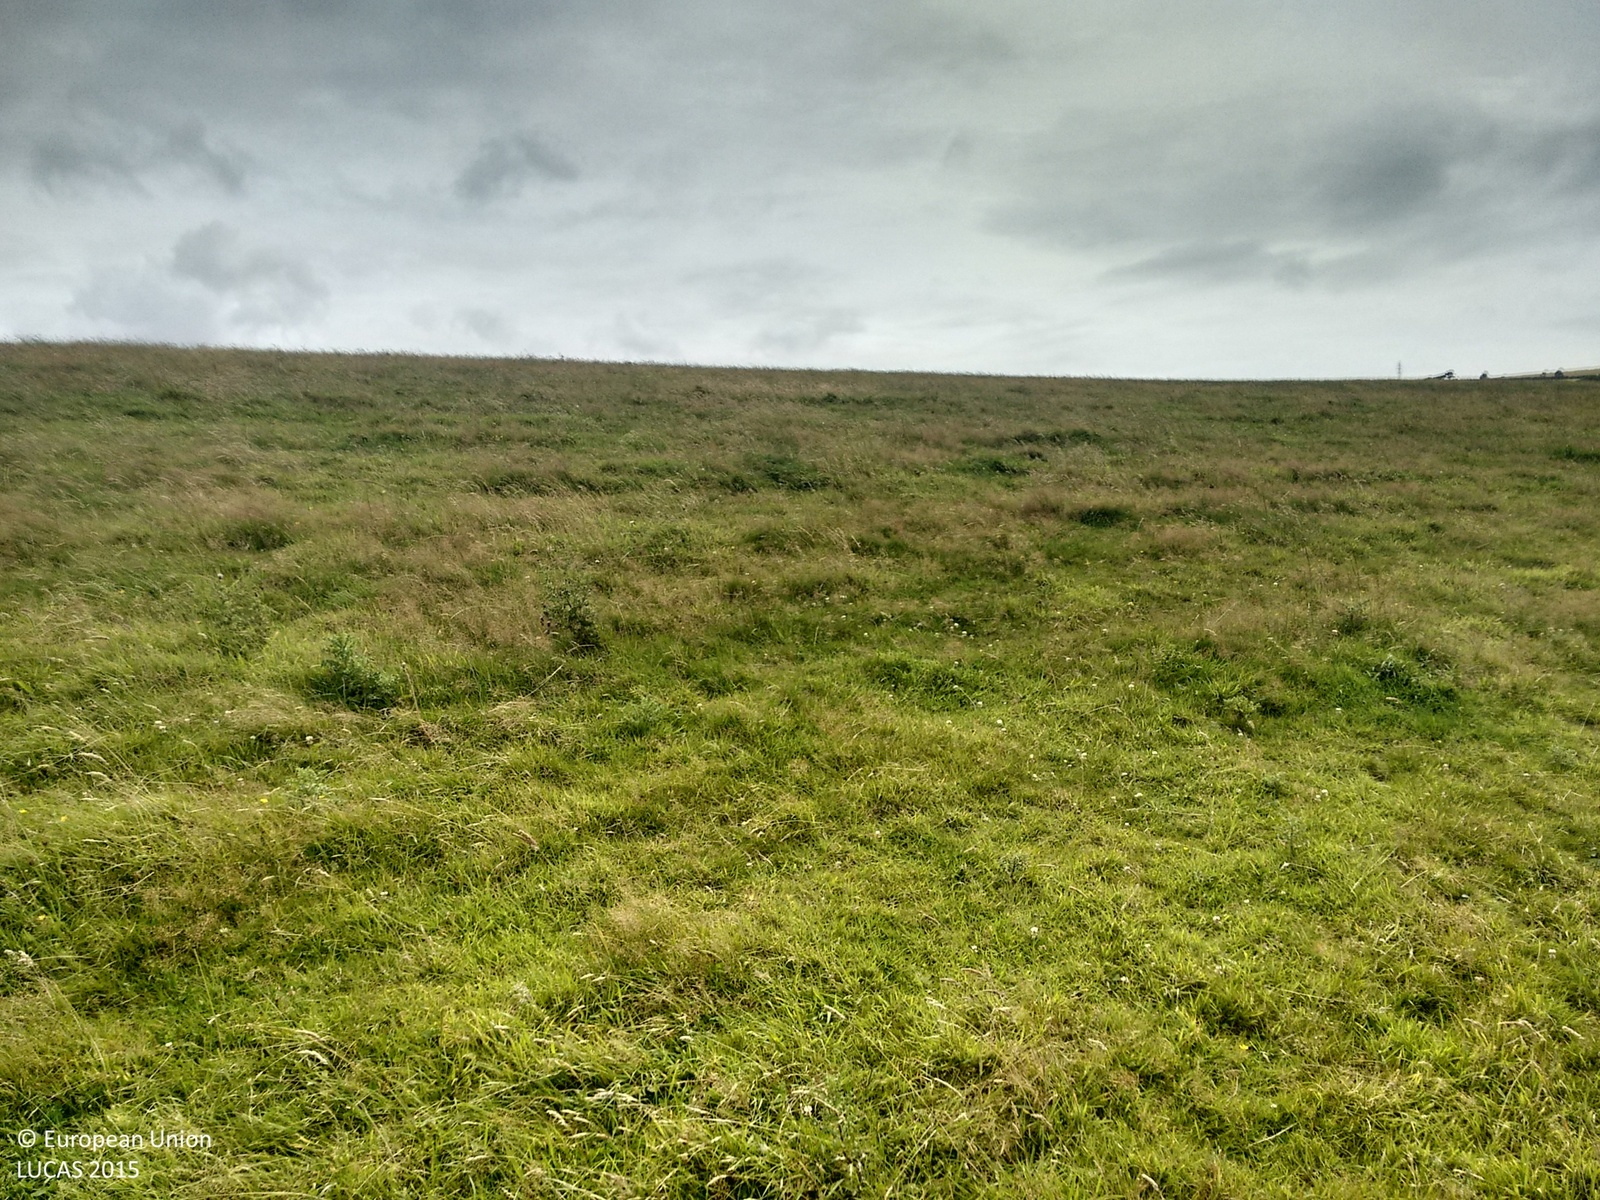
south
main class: Woodland
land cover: Broadleaved woodland
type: mesophytic deciduous forest
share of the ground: > 75 %
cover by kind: broadleaved forest trees 100 %
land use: Forestry
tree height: < 5 m
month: August
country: GB
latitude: 50.3867
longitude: -3.7451
